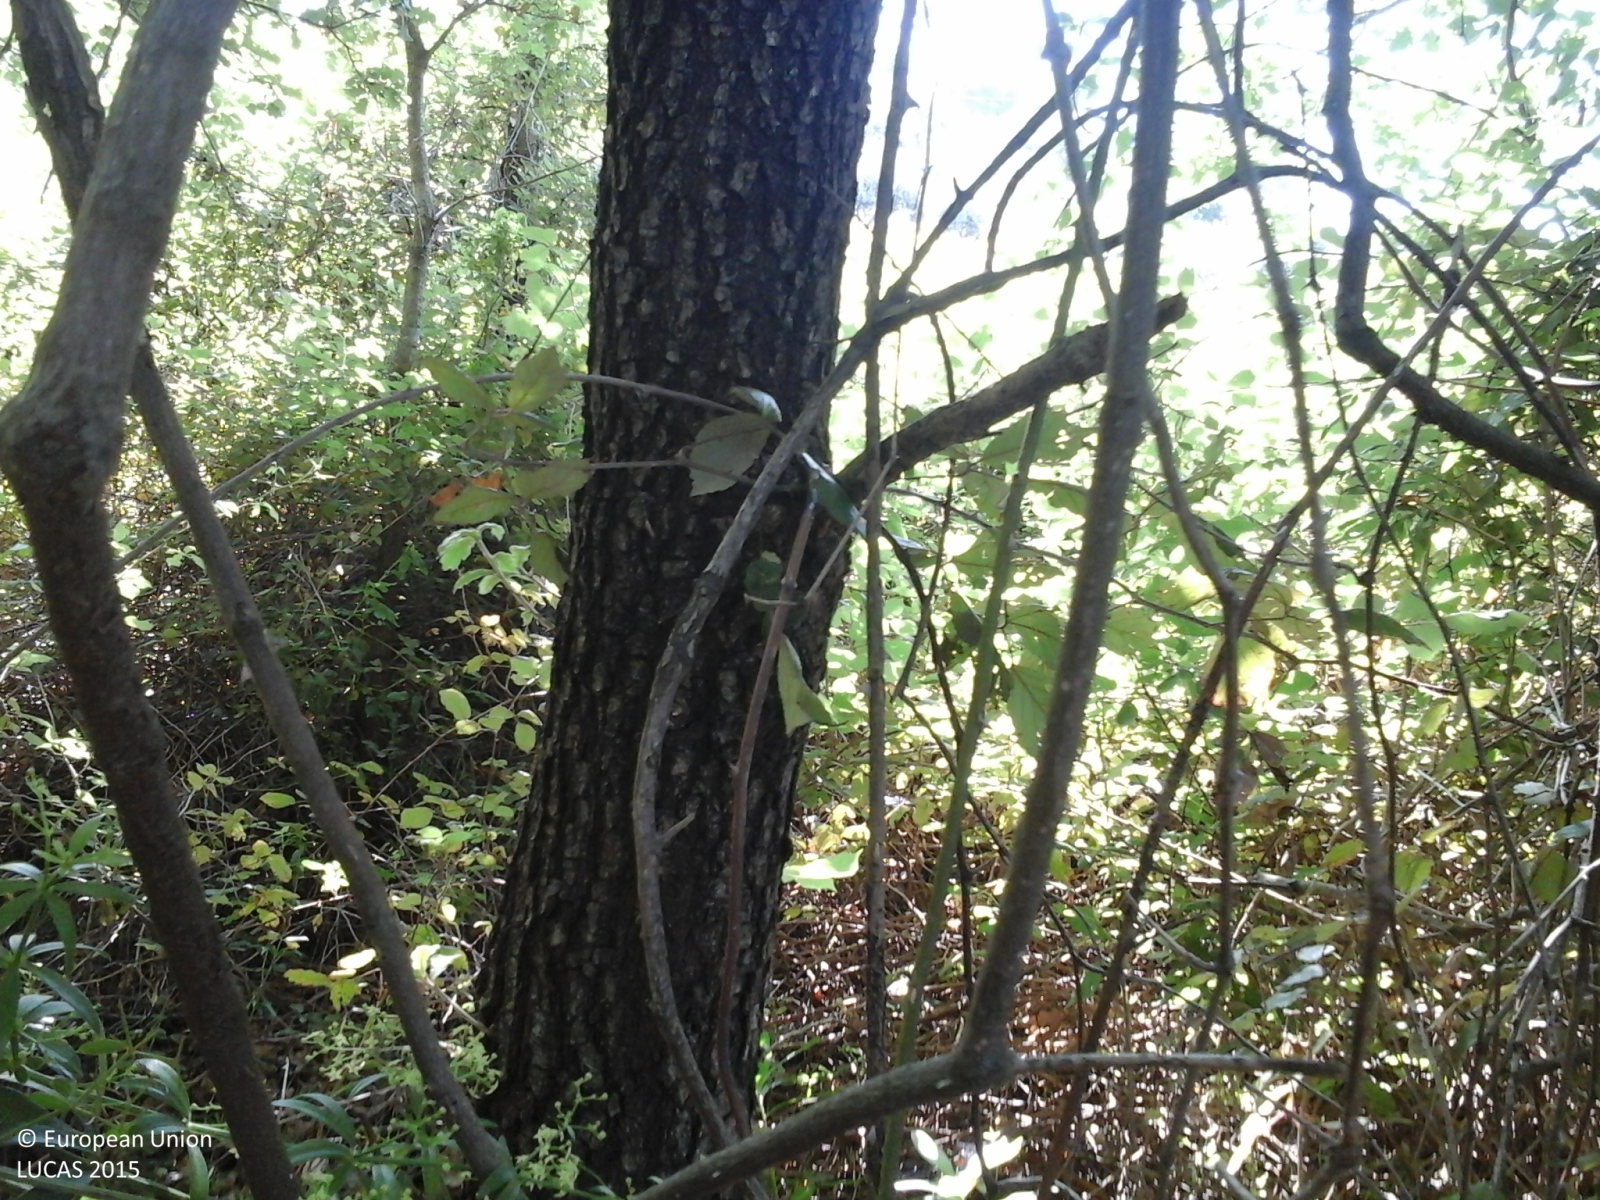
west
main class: Woodland
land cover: Broadleaved woodland
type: thermophilous deciduous forest
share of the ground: > 75 %
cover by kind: broadleaved forest trees 90 %, shrubs 5 %, herbaceous plants 5 %
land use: Forestry
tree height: < 5 m
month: May
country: IT
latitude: 37.9879
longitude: 14.0594
